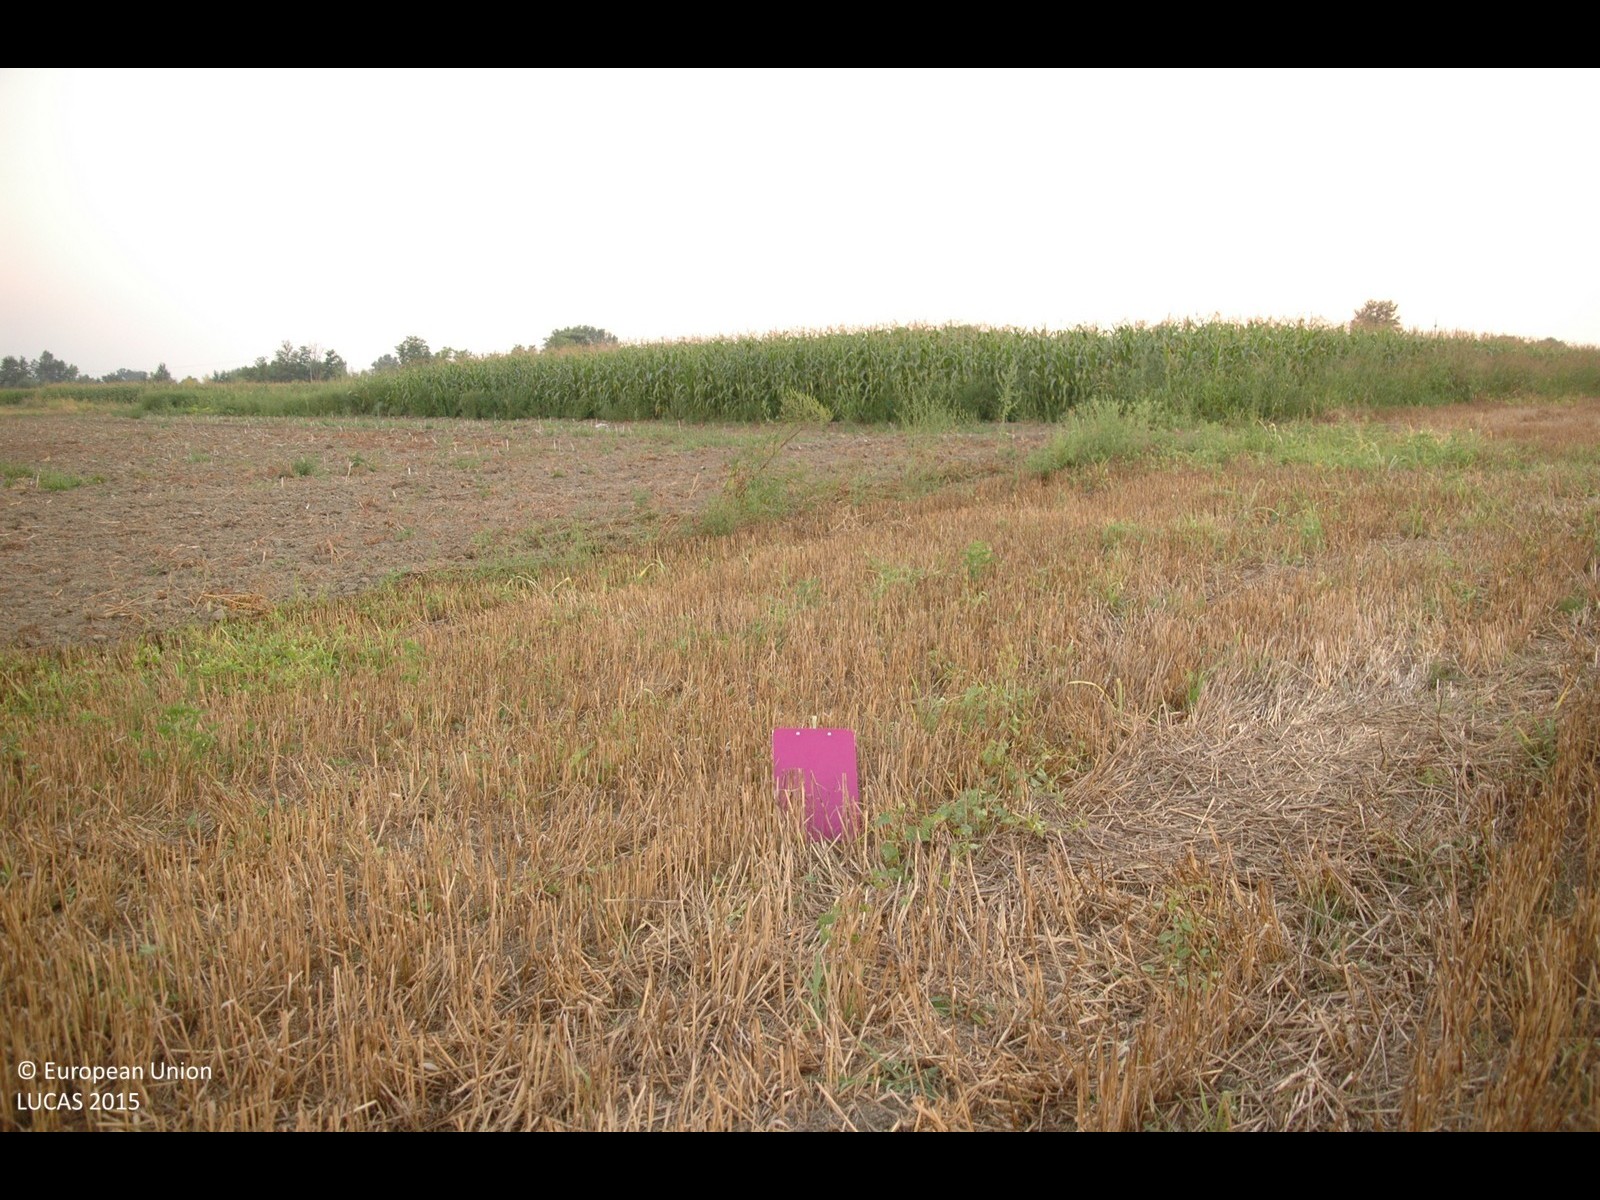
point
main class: Cropland
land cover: Common wheat
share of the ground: > 75 %
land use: Agriculture (excluding fallow land and kitchen gardens)
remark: Harvested field
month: August
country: HR
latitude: 46.2342
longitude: 16.9393
